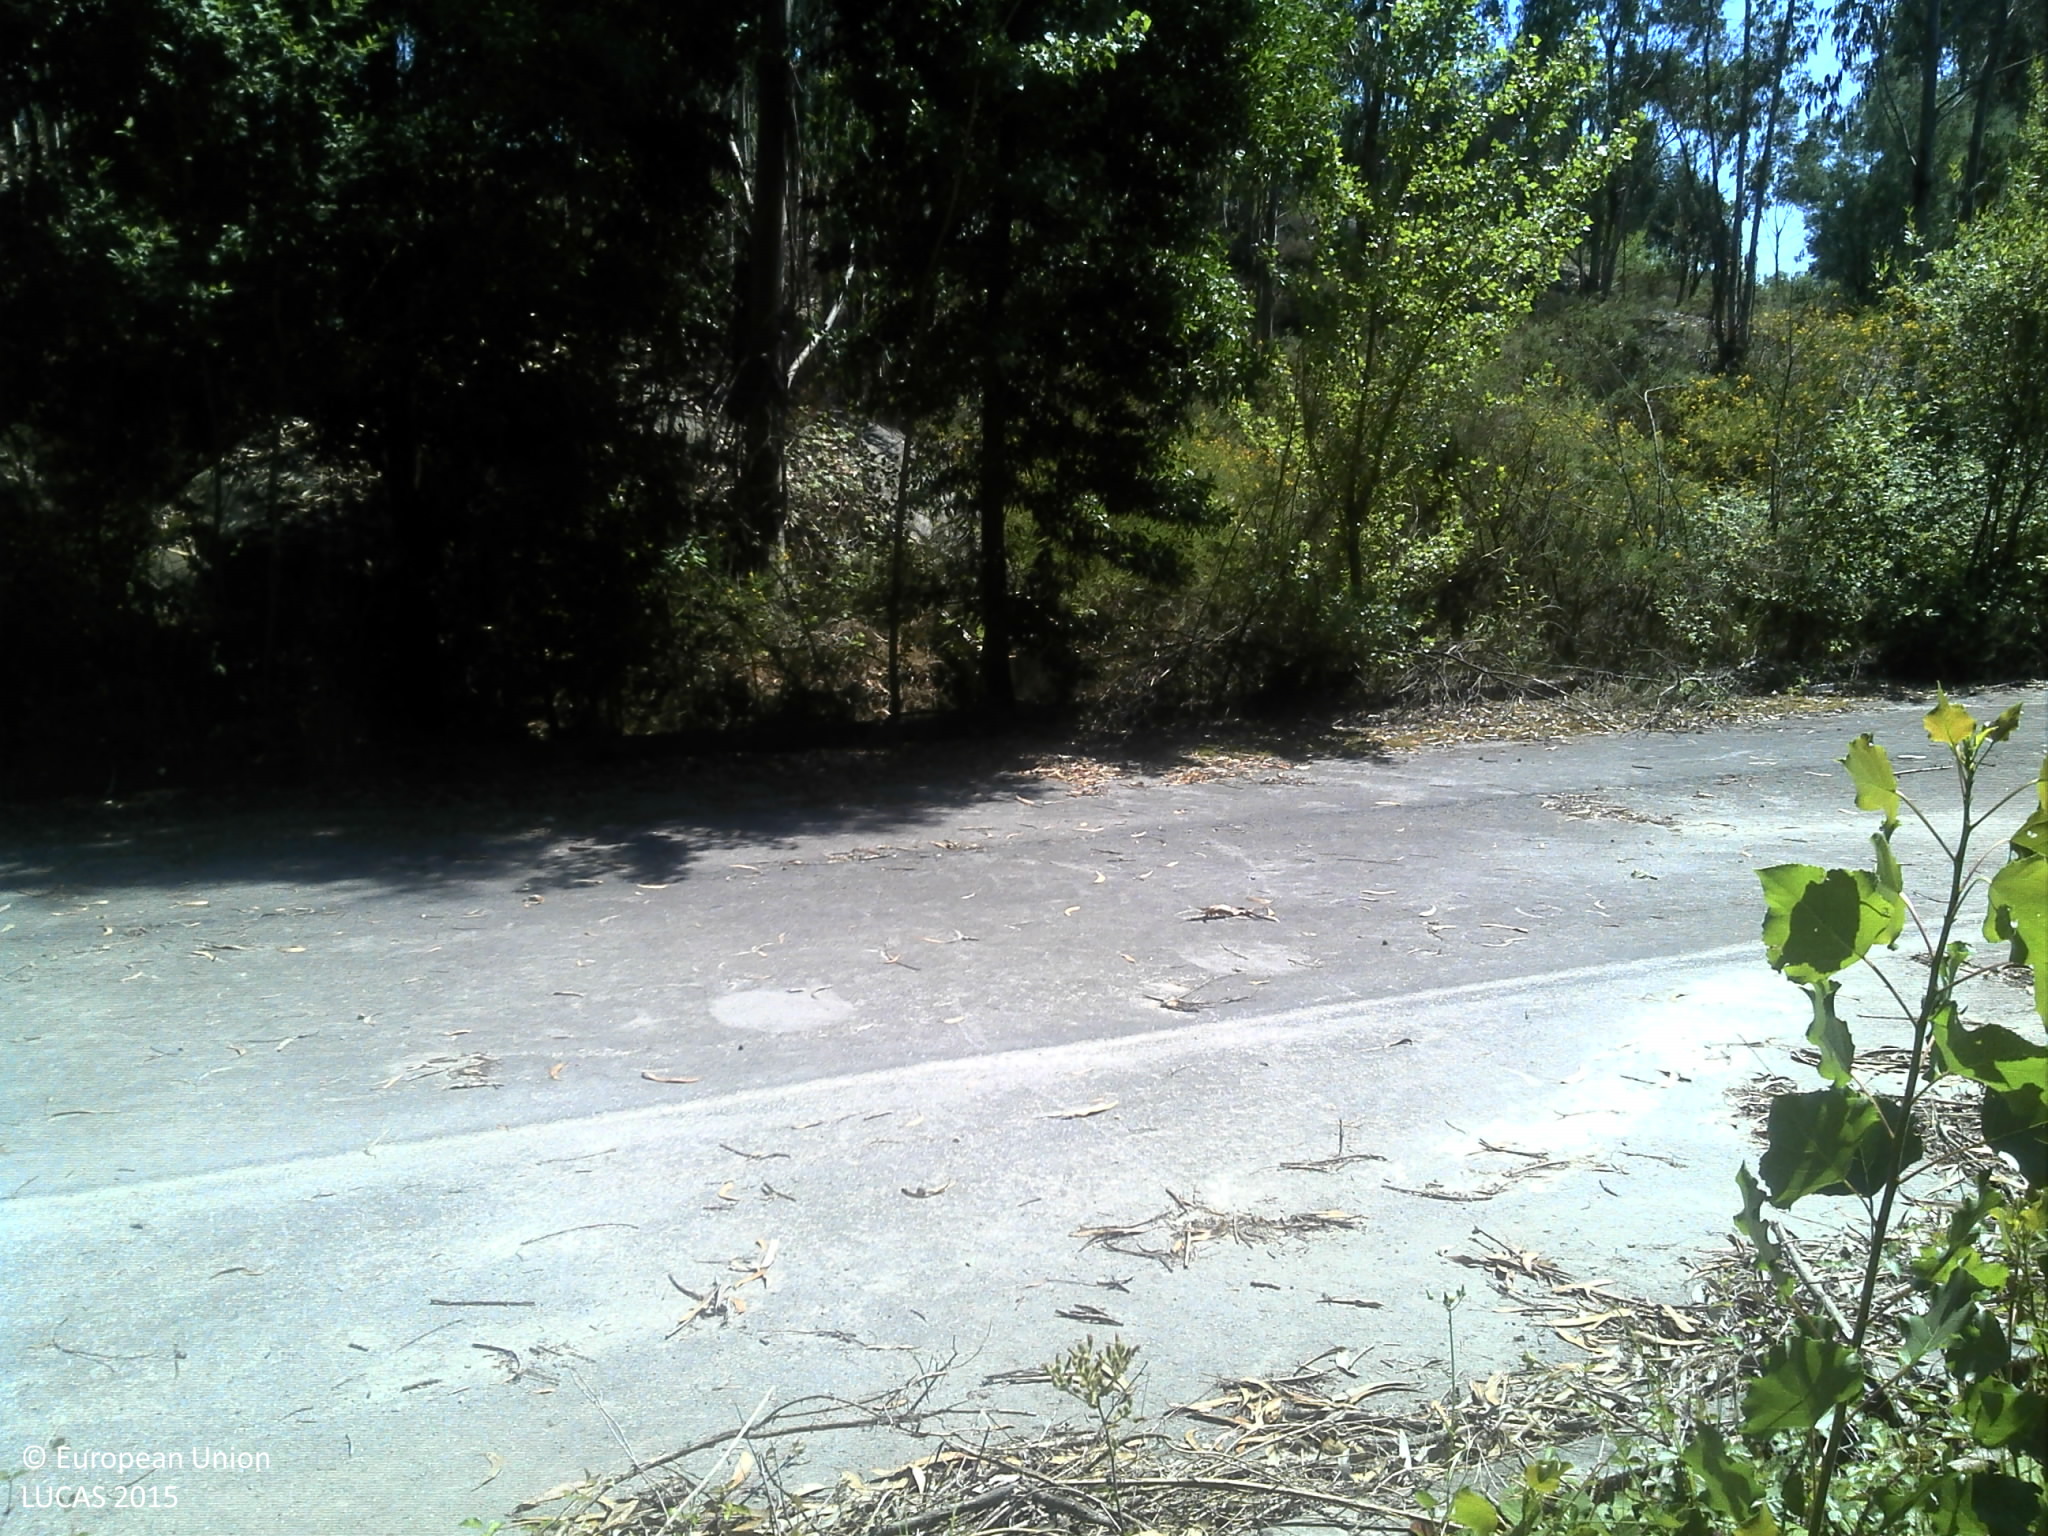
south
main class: Shrubland
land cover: Shrubland with sparse tree cover
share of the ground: > 75 %
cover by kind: shrubs 85 %, unconsolidated bare surface 10 %, broadleaved forest trees 5 %
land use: Semi-natural and natural areas not in use
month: June
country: PT
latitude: 41.5274
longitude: -8.2819
